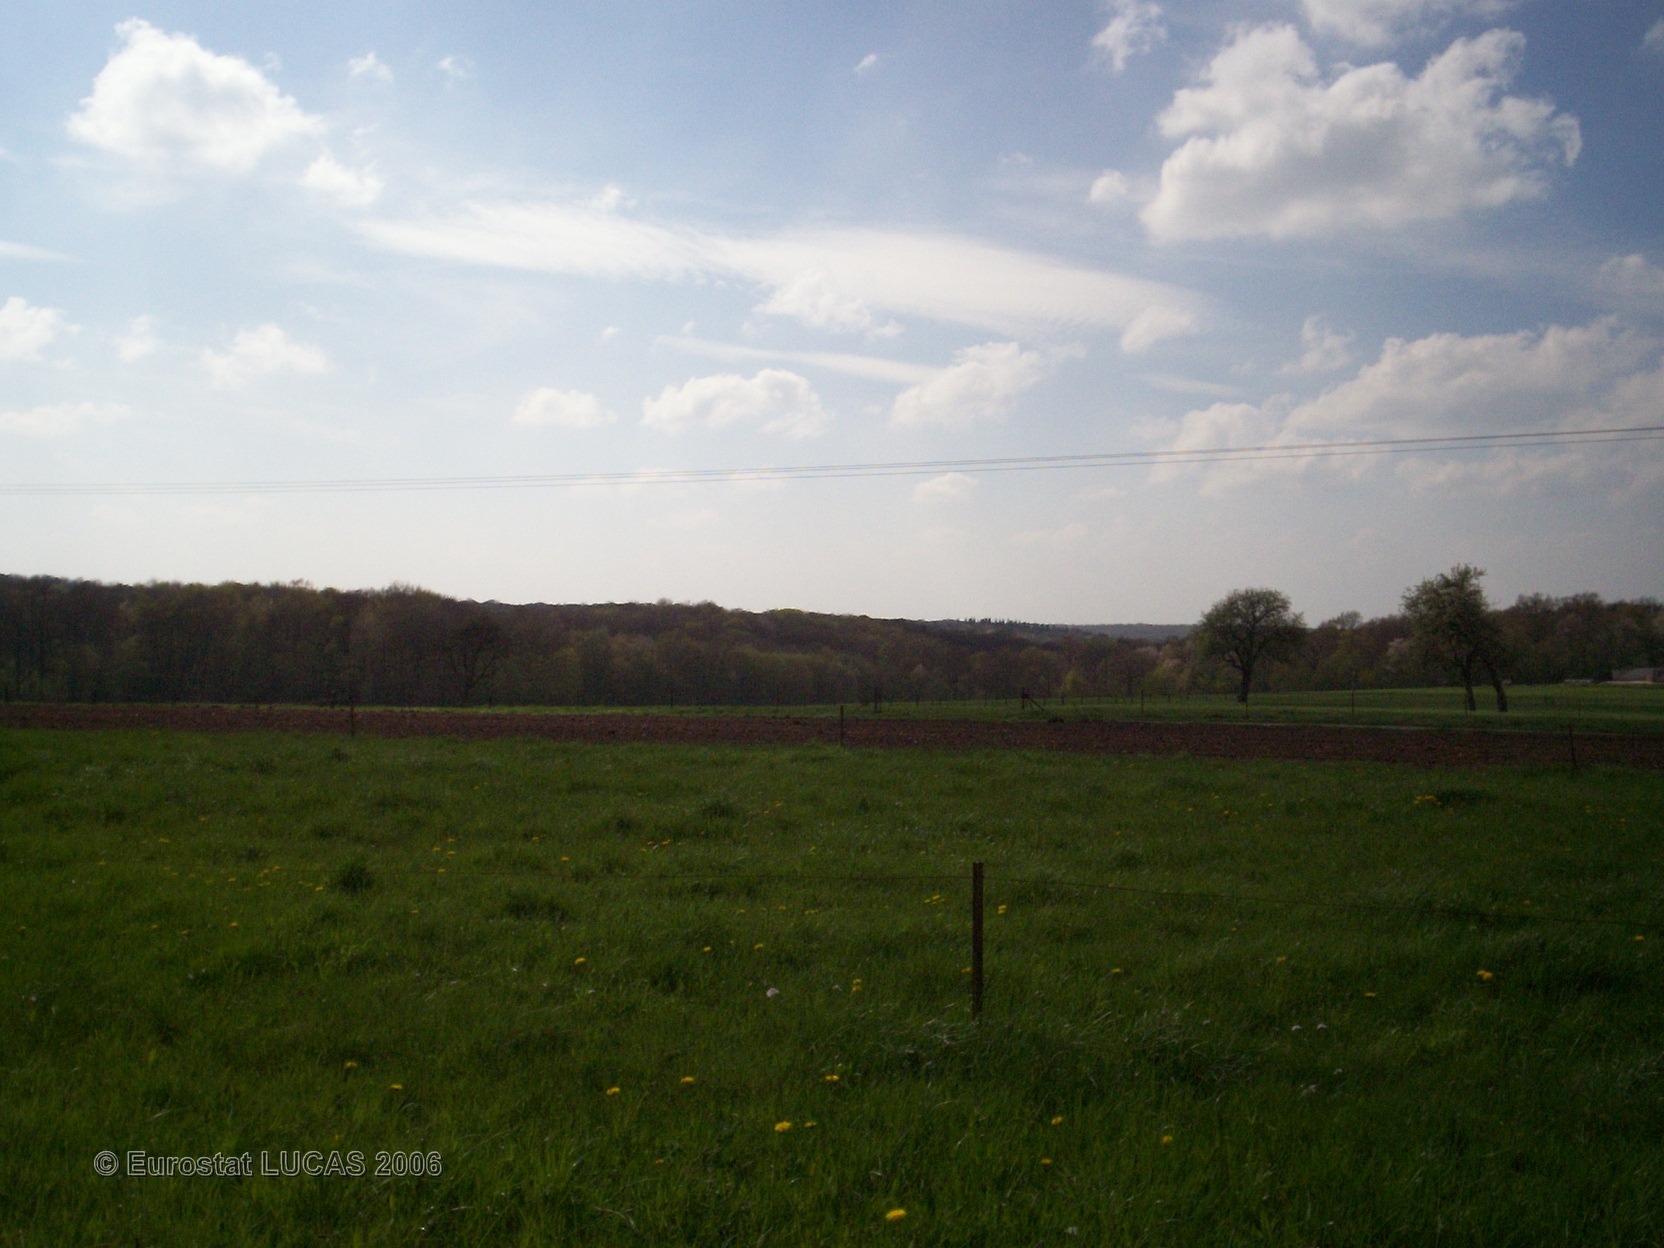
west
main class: Grassland
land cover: Grassland without tree/shrub cover
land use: Agriculture (excluding fallow land and kitchen gardens)
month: May
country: FR
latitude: 49.7886
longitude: 4.2866
